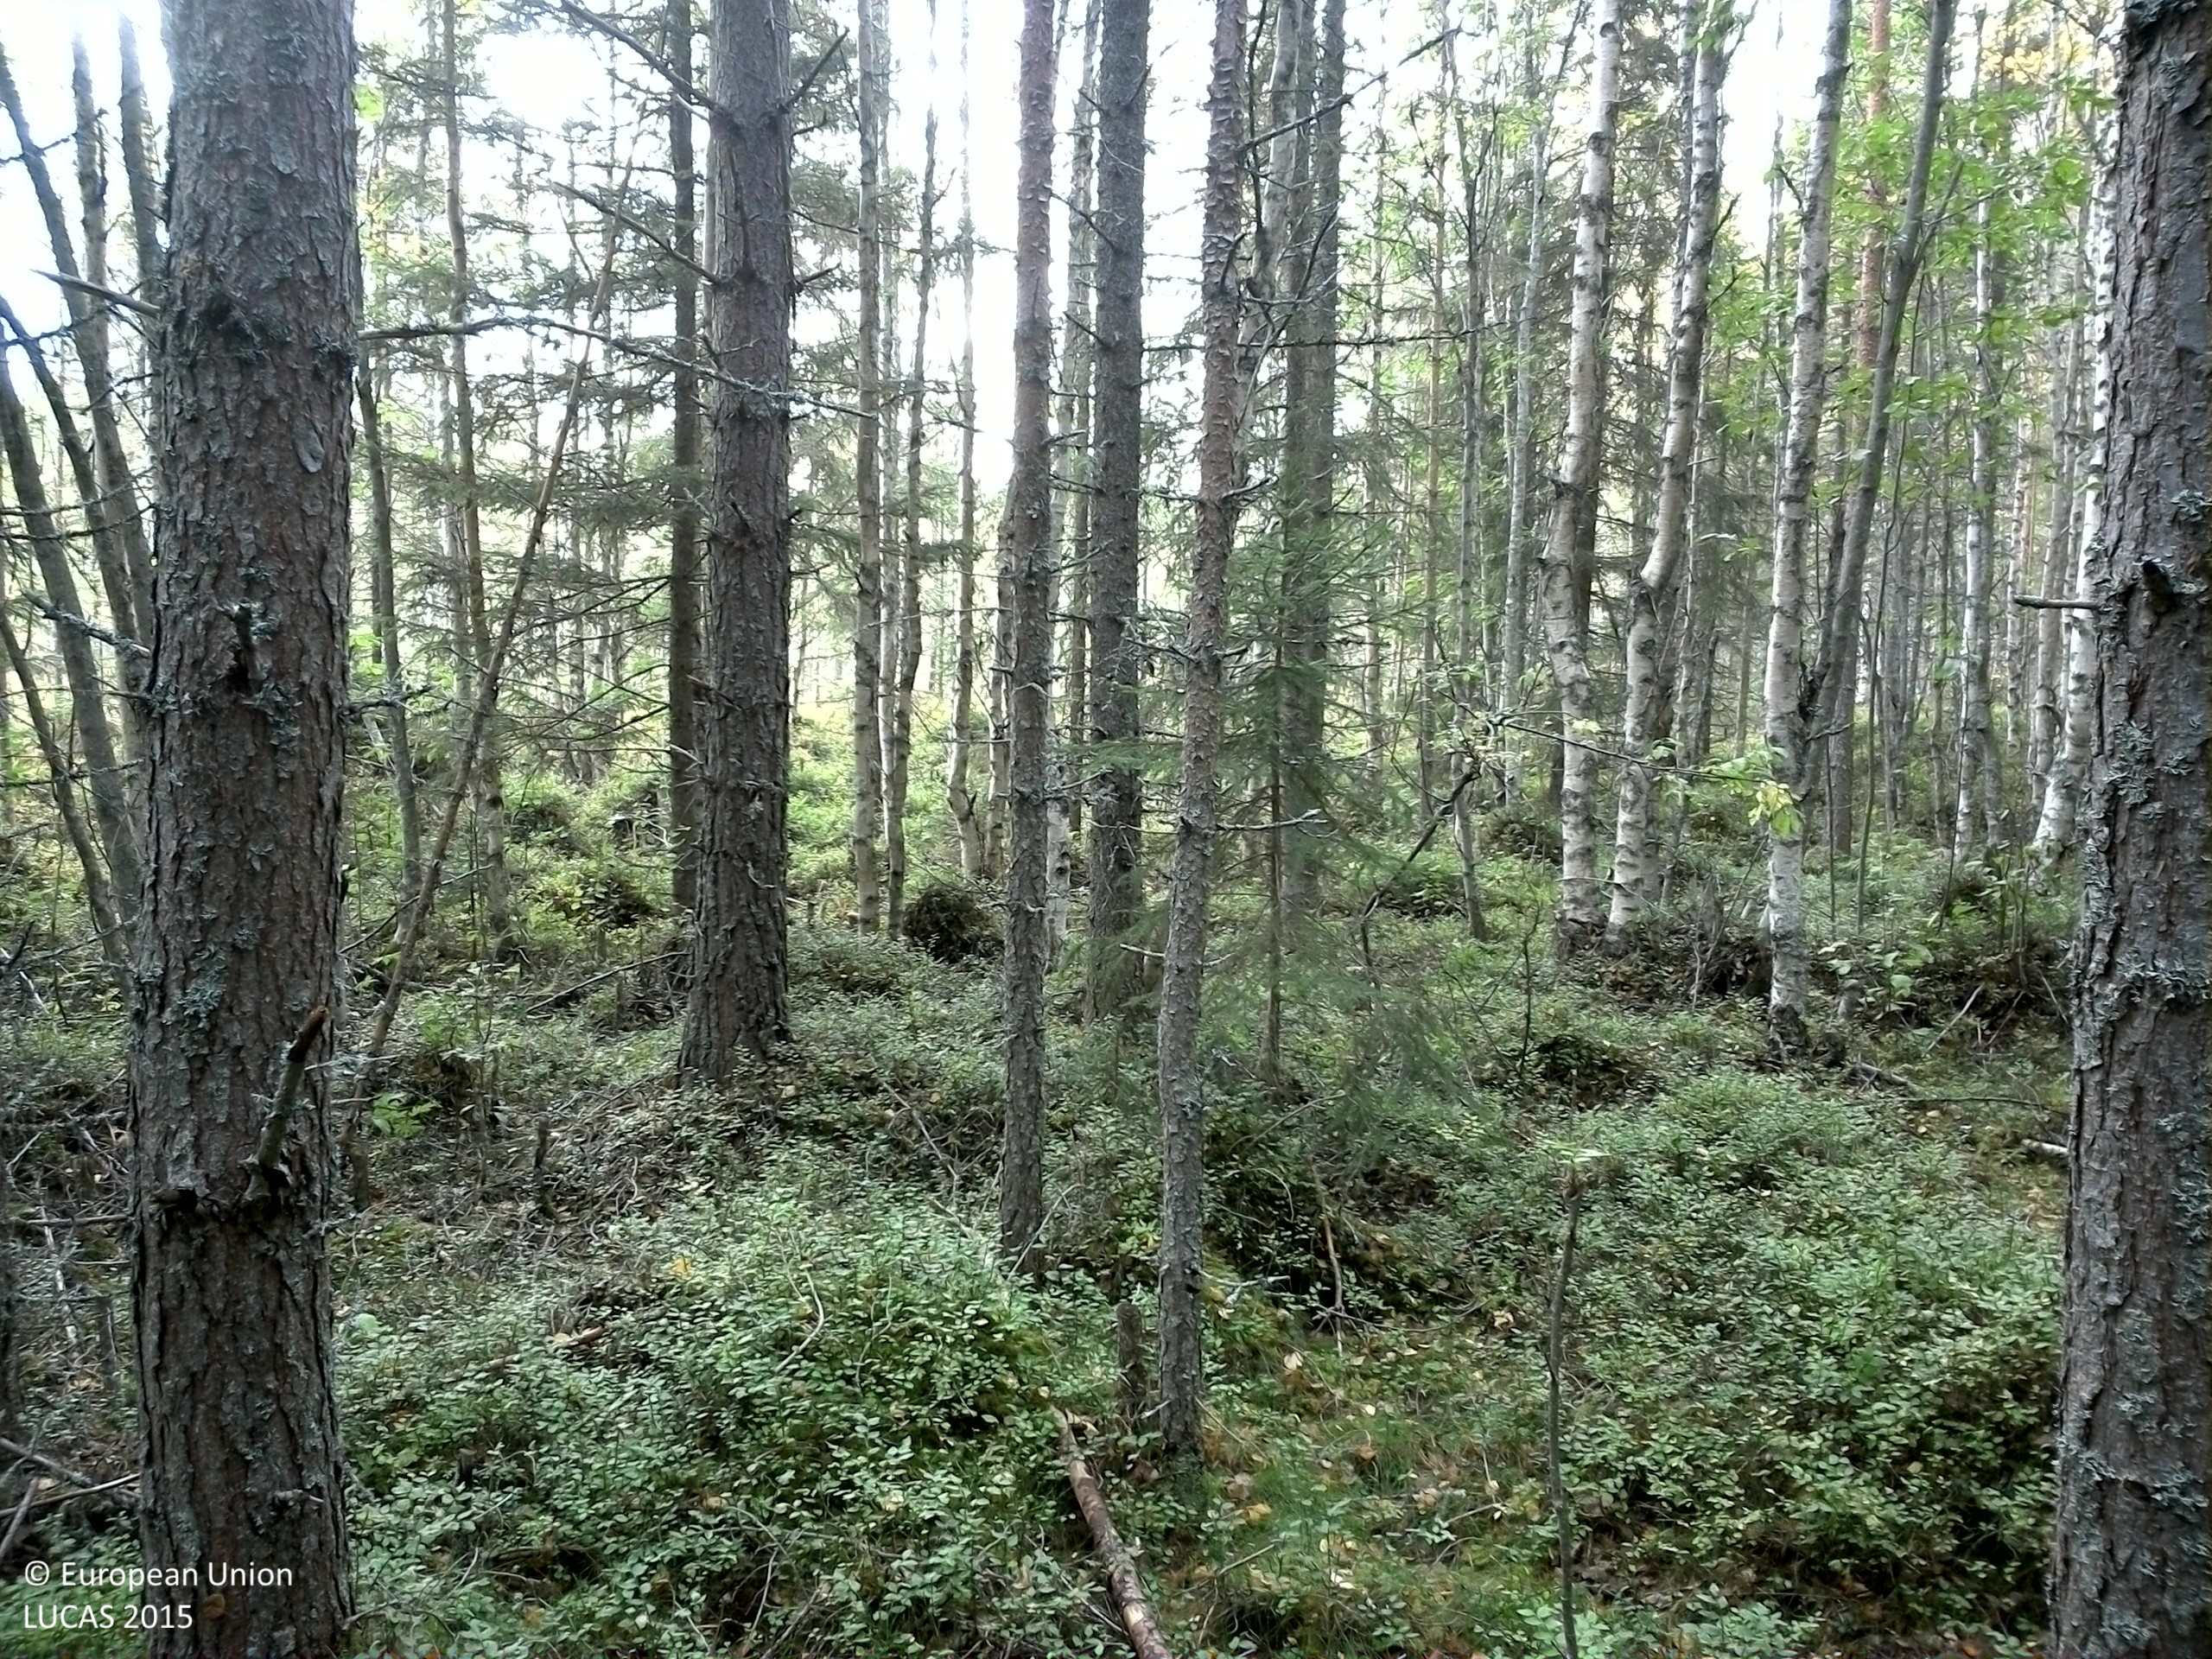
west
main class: Woodland
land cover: Spruce dominated mixed woodland
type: boreal forest
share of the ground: > 75 %
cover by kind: coniferous forest trees 50 %, broadleaved forest trees 25 %, shrubs 20 %, lichens and mosses 5 %
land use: Forestry
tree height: > 5 m
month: September
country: SE
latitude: 61.2684
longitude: 15.4116
